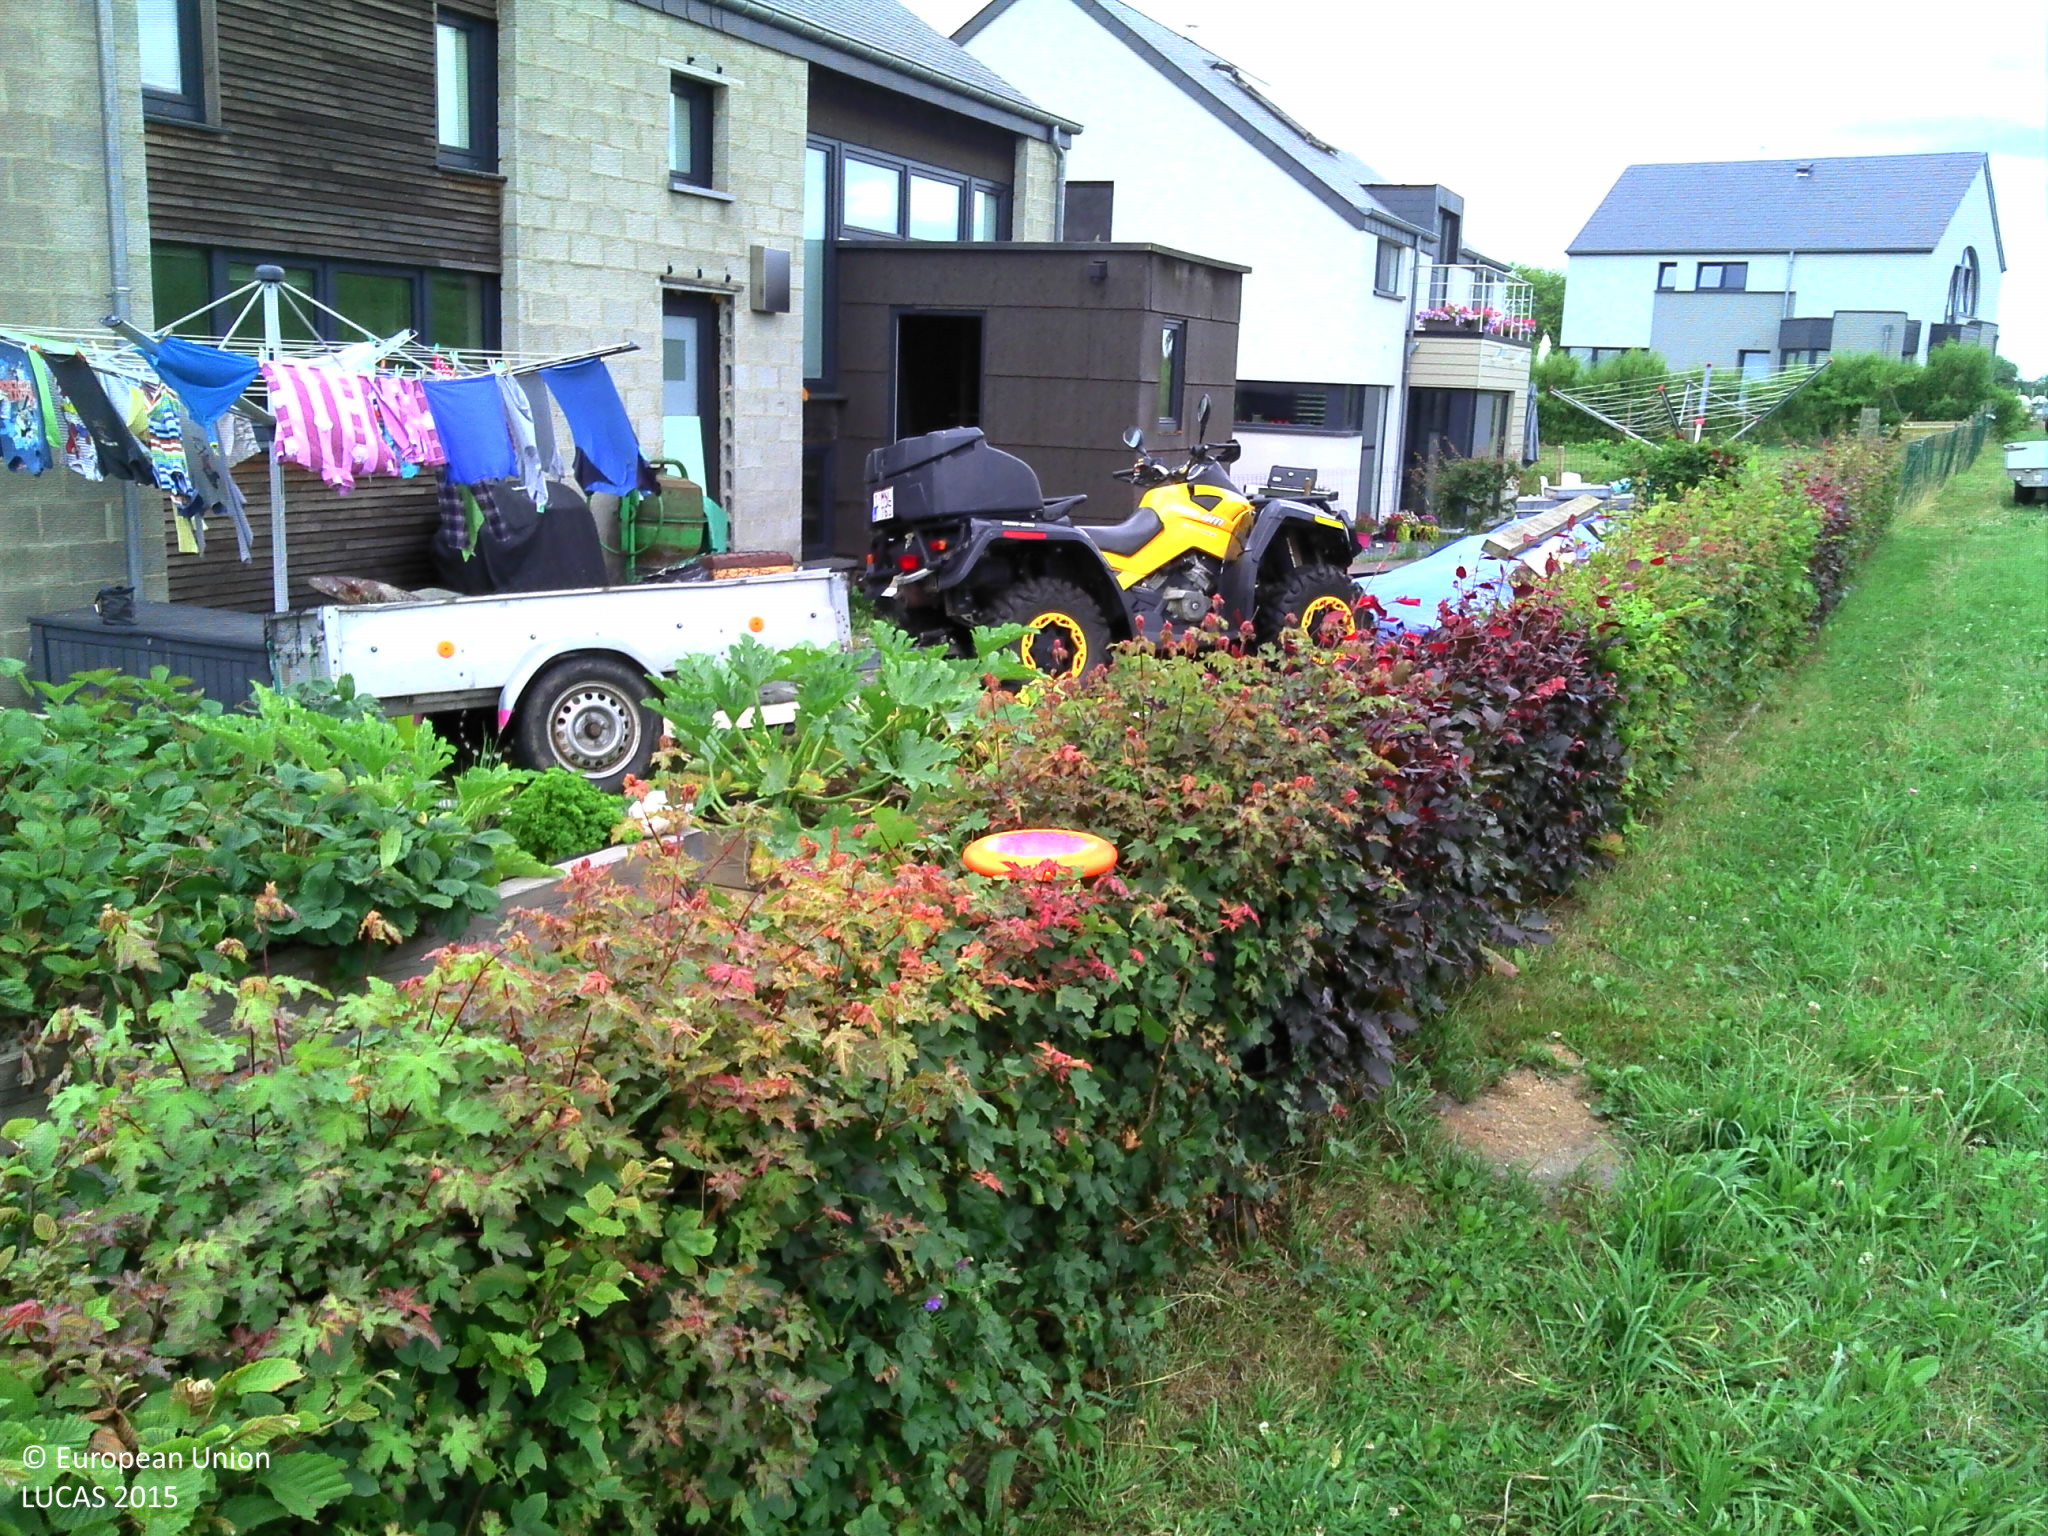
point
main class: Grassland
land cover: Grassland without tree/shrub cover
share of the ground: > 75 %
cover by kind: herbaceous plants 100 %
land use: Residential
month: July
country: BE
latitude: 49.7761
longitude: 5.6244
